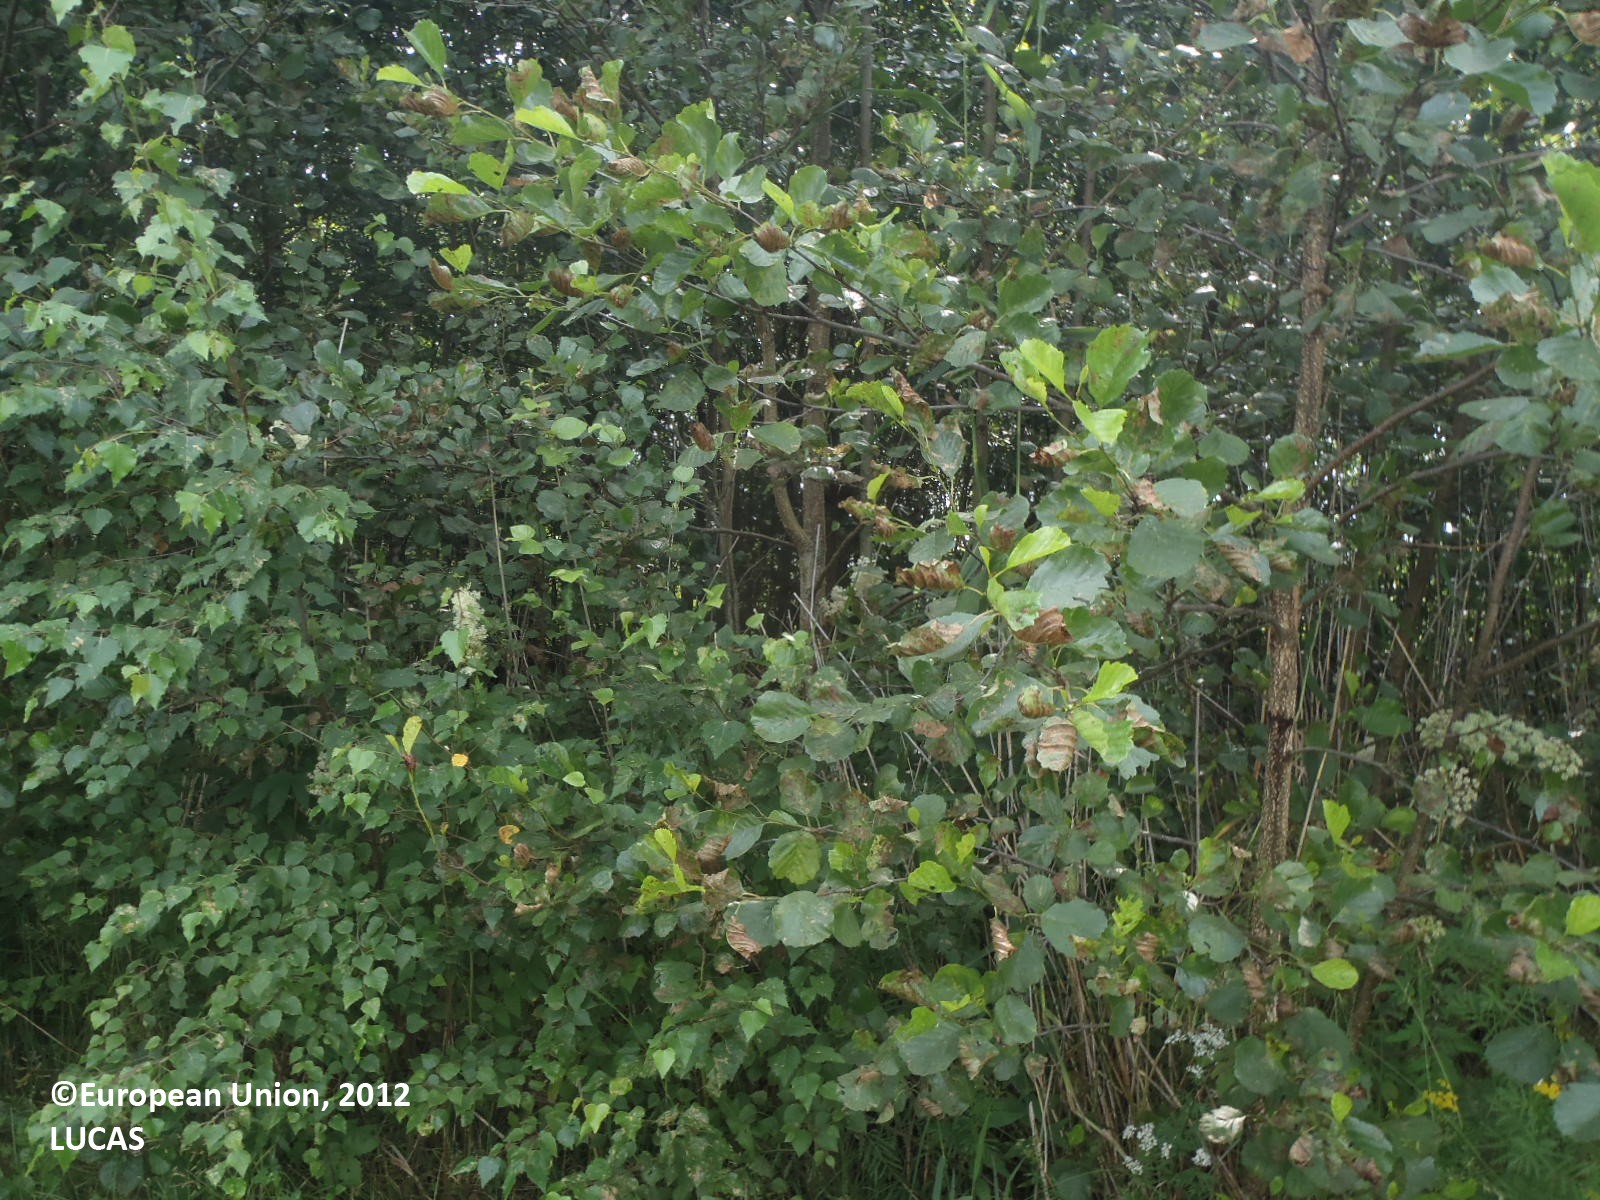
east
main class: Grassland
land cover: Grassland without tree/shrub cover
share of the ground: > 75 %
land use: Amenities, museums, leisure
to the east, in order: Grassland without tree/shrub cover; Broadleaved woodland; Transitional water bodies; Broadleaved woodland; Grassland with sparse tree/shrub cover; Electric lines; Grassland with sparse tree/shrub cover; Pine dominated mixed woodland; Grassland without tree/shrub cover; Paved roads, cycling and walking lanes; Managed hedges; Pine dominated mixed woodland; Fences; Grass margins; Temporary grasslands; Broadleaved woodland; Ditches and canals; Broadleaved woodland
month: July
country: FI
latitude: 60.5567
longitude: 21.8235
